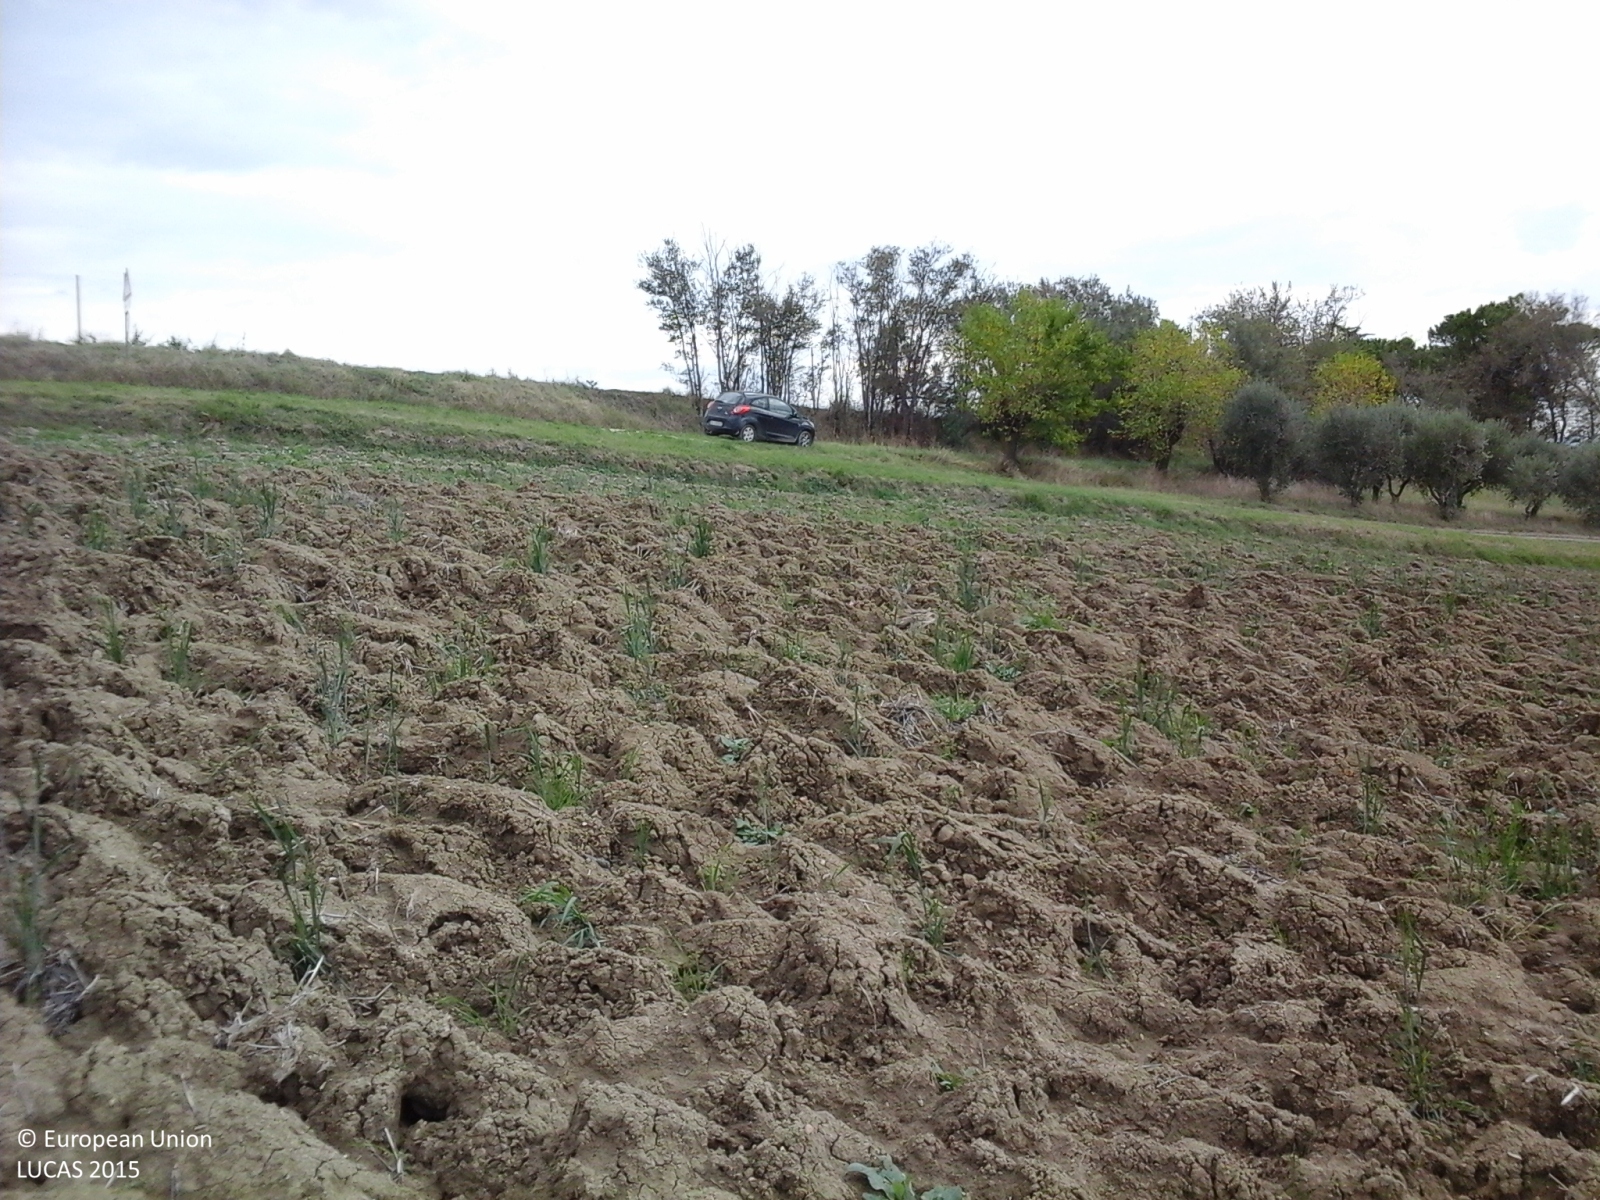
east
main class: Cropland
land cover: Durum wheat
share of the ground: < 10 %
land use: Agriculture (excluding fallow land and kitchen gardens)
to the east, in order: Durum wheat; Grass margins; Paved roads, cycling and walking lanes; Grass margins; Paved roads, cycling and walking lanes; Abandoned hedges; Sunflower; Electric lines; Sunflower; Grassland without tree/shrub cover; Broadleaved woodland; Sunflower
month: October
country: IT
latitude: 43.5626
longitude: 13.1492
